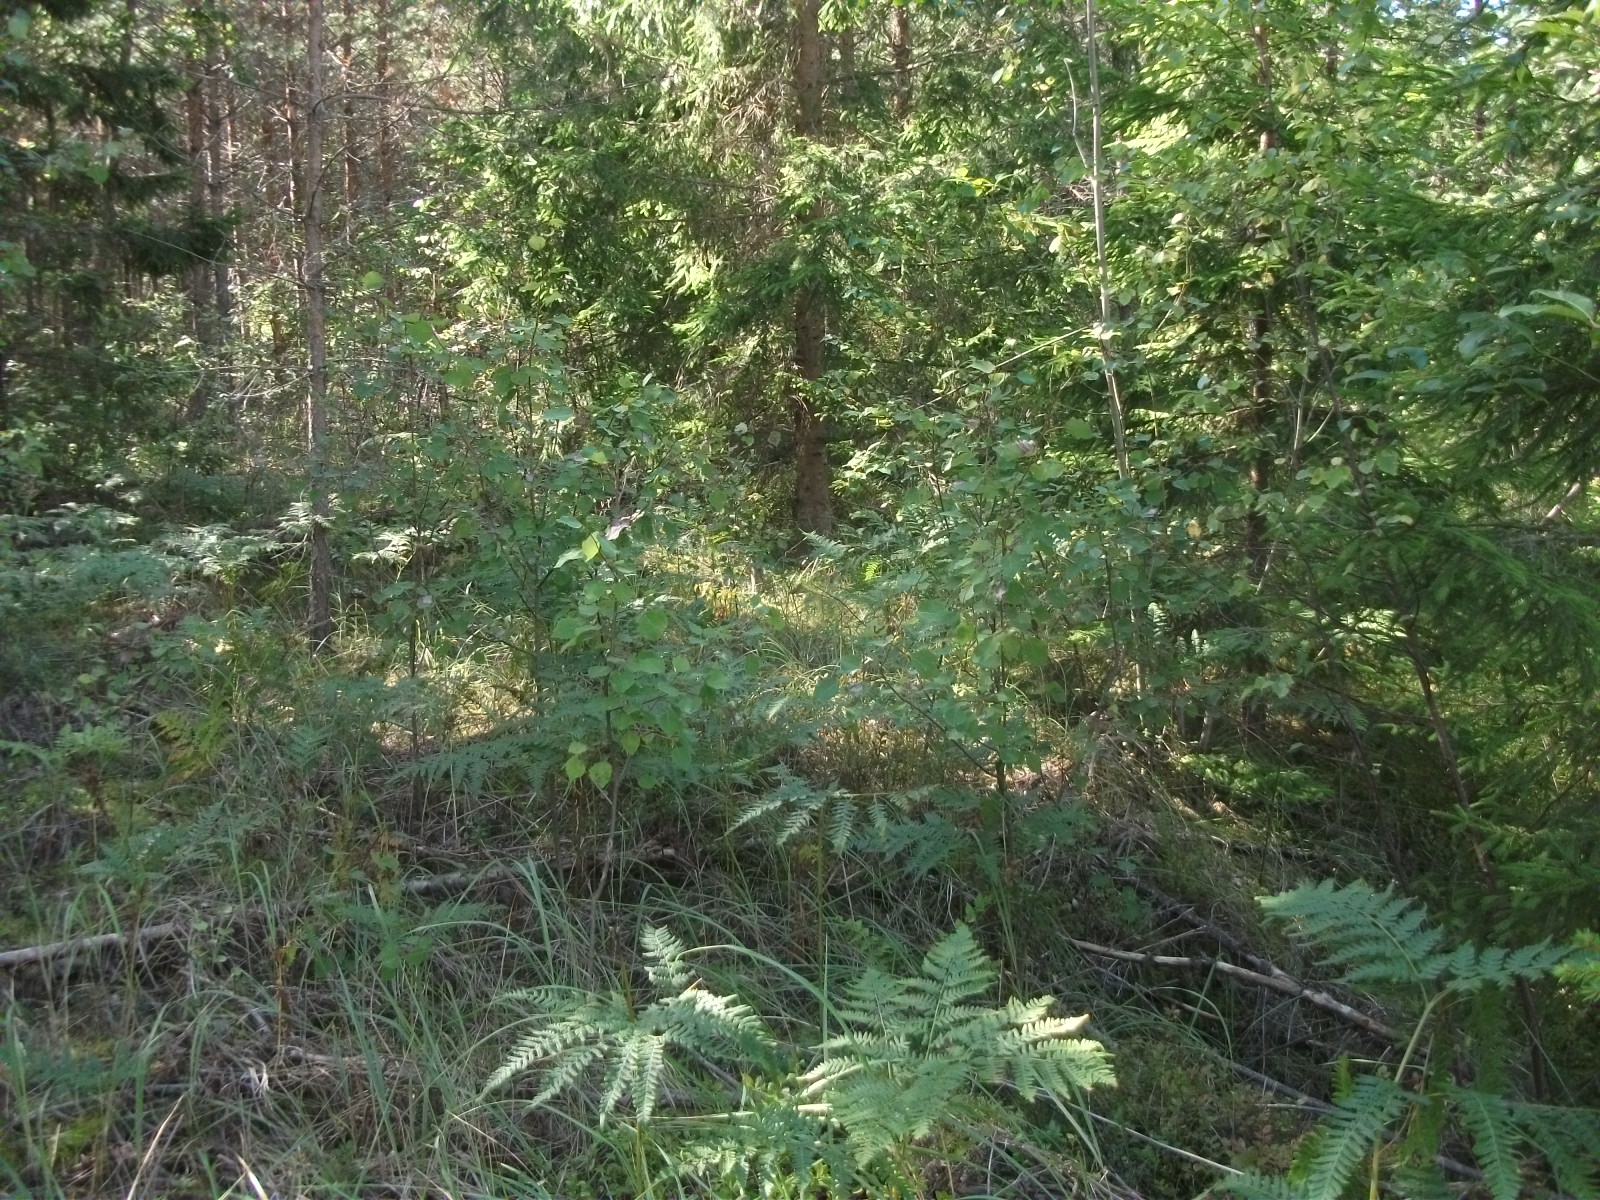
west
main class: Woodland
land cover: Other coniferous woodland
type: hemiboreal forest and nemoral coniferous forest and mixed broadleaved-coniferous forest
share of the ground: > 75 %
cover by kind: coniferous forest trees 80 %, herbaceous plants 10 %, shrubs 5 %, lichens and mosses 5 %
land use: Forestry
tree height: > 5 m
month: August
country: LV
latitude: 56.6109
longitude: 26.1197
